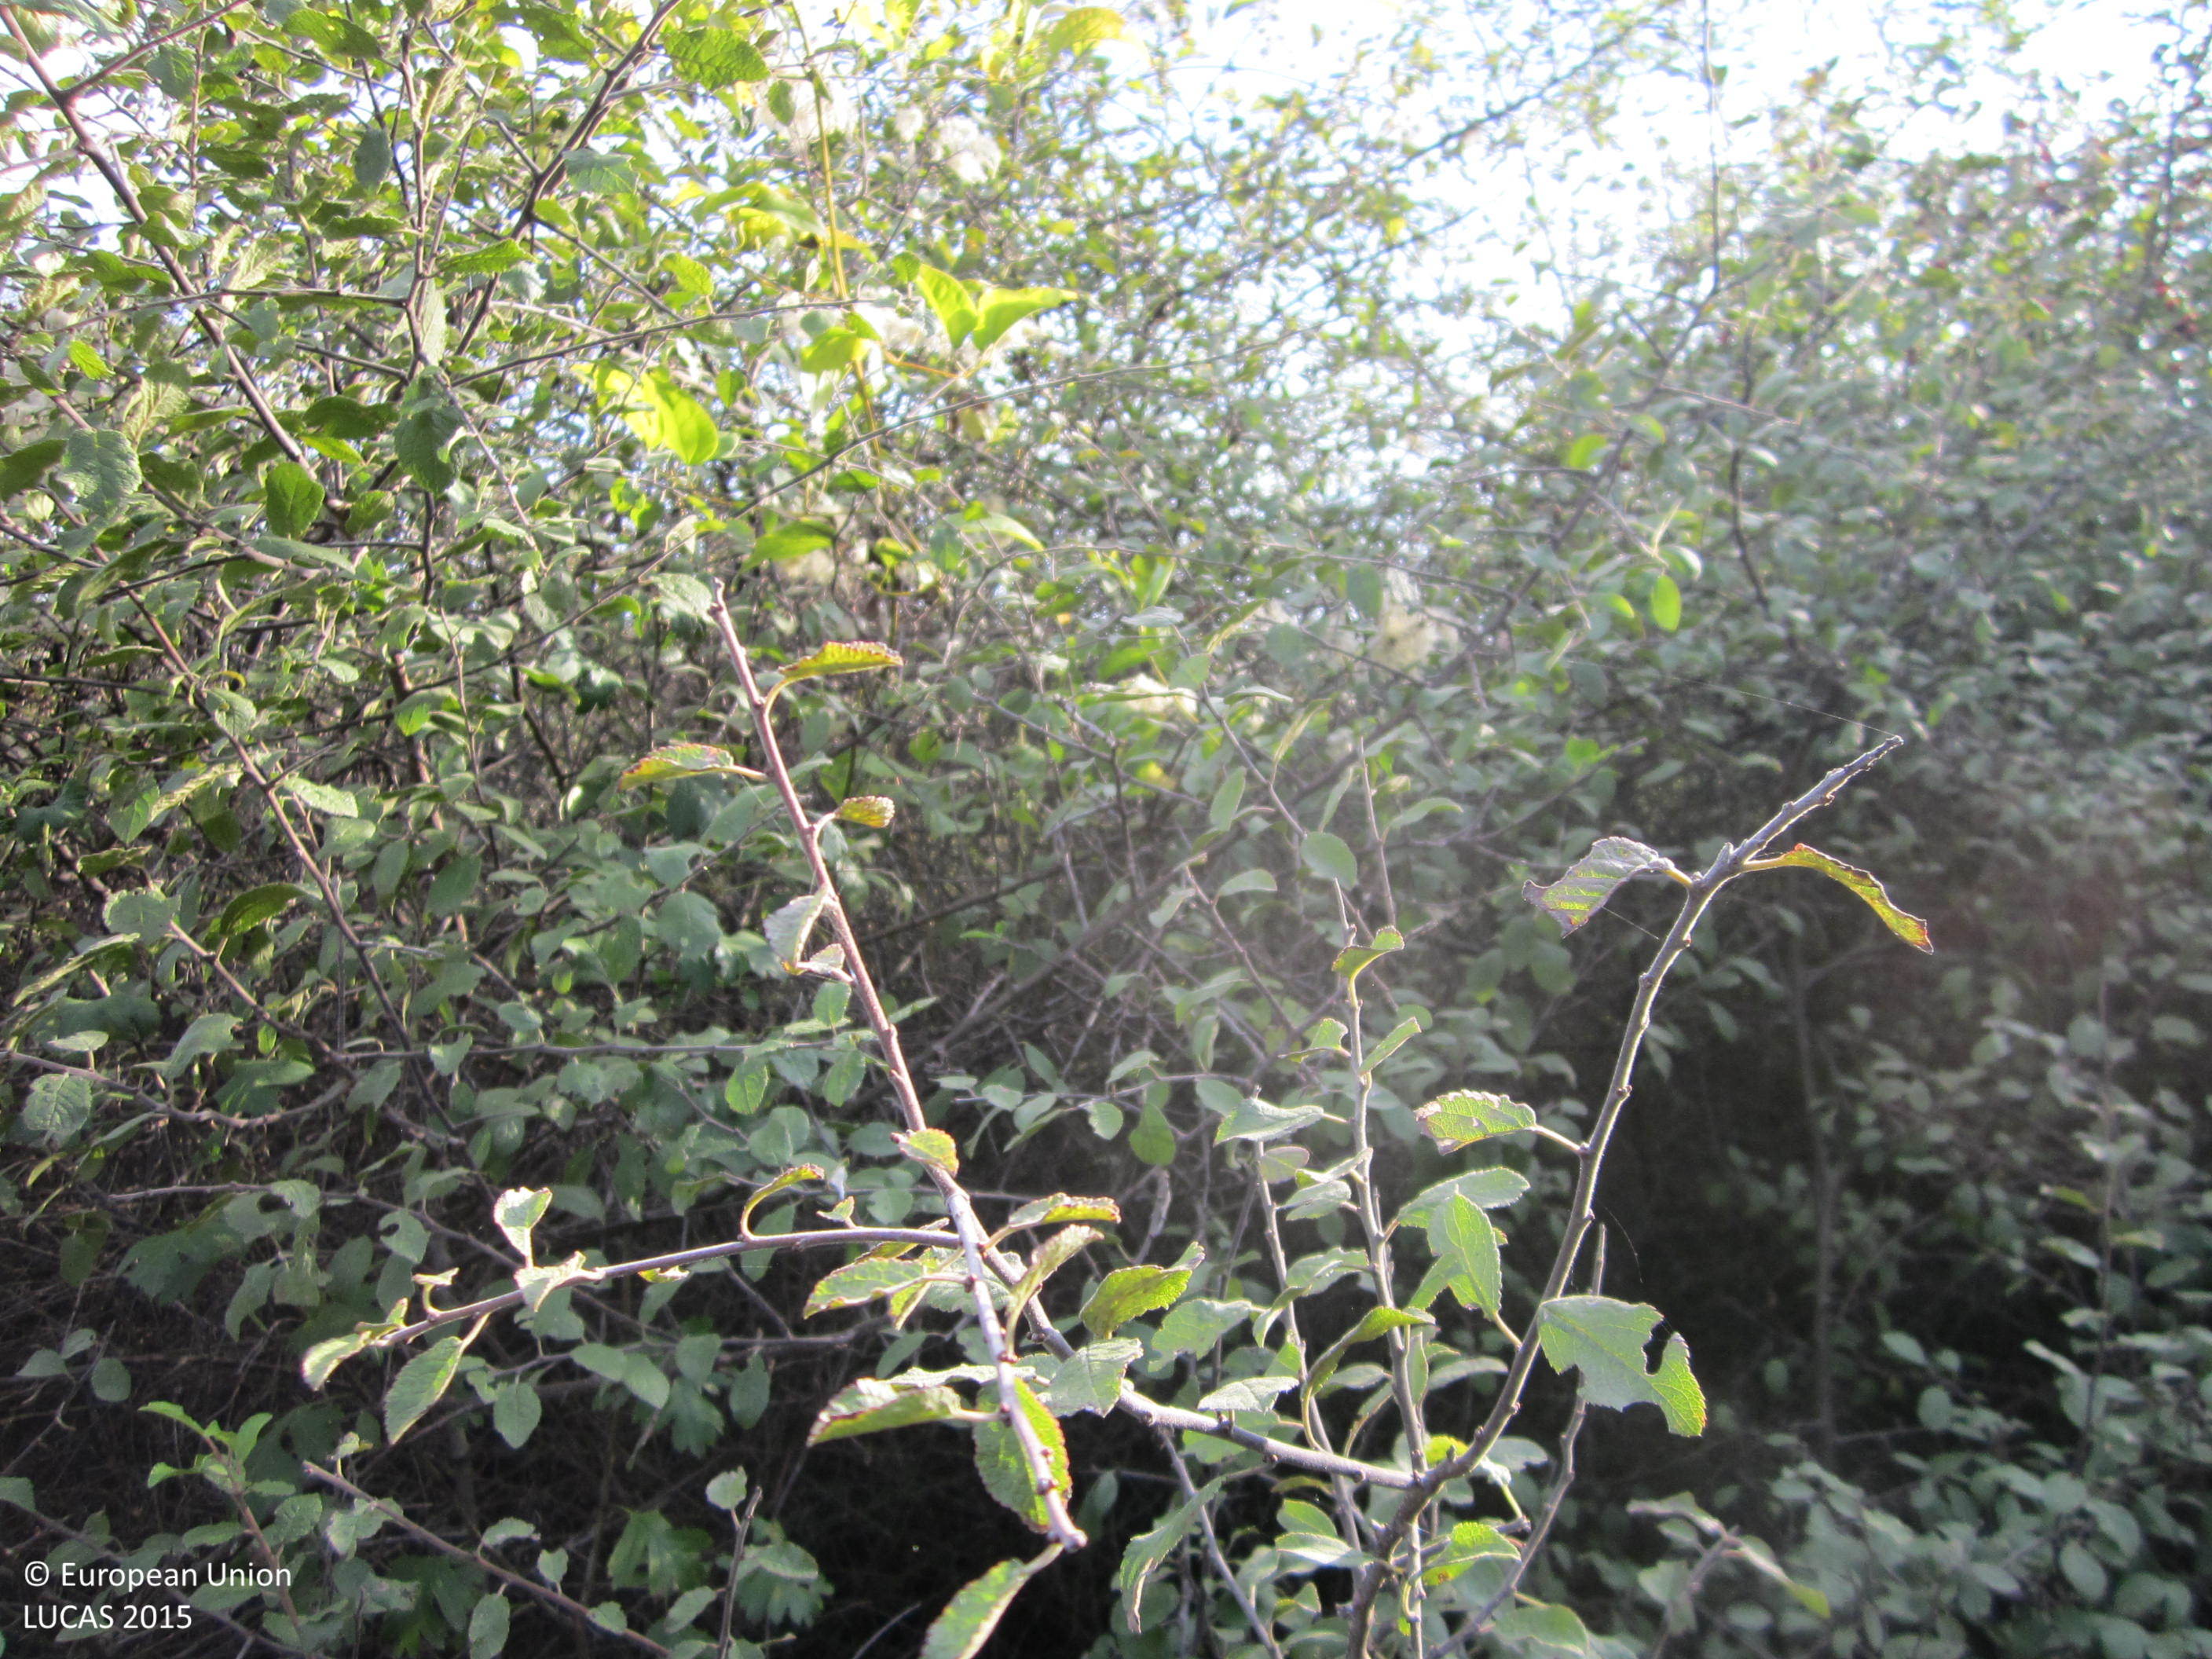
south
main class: Shrubland
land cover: Shrubland with sparse tree cover
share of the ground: 50 - 75 %
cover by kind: shrubs 55 %, herbaceous plants 40 %, broadleaved forest trees 5 %
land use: Semi-natural and natural areas not in use
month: October
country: BG
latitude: 42.7786
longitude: 26.8374
